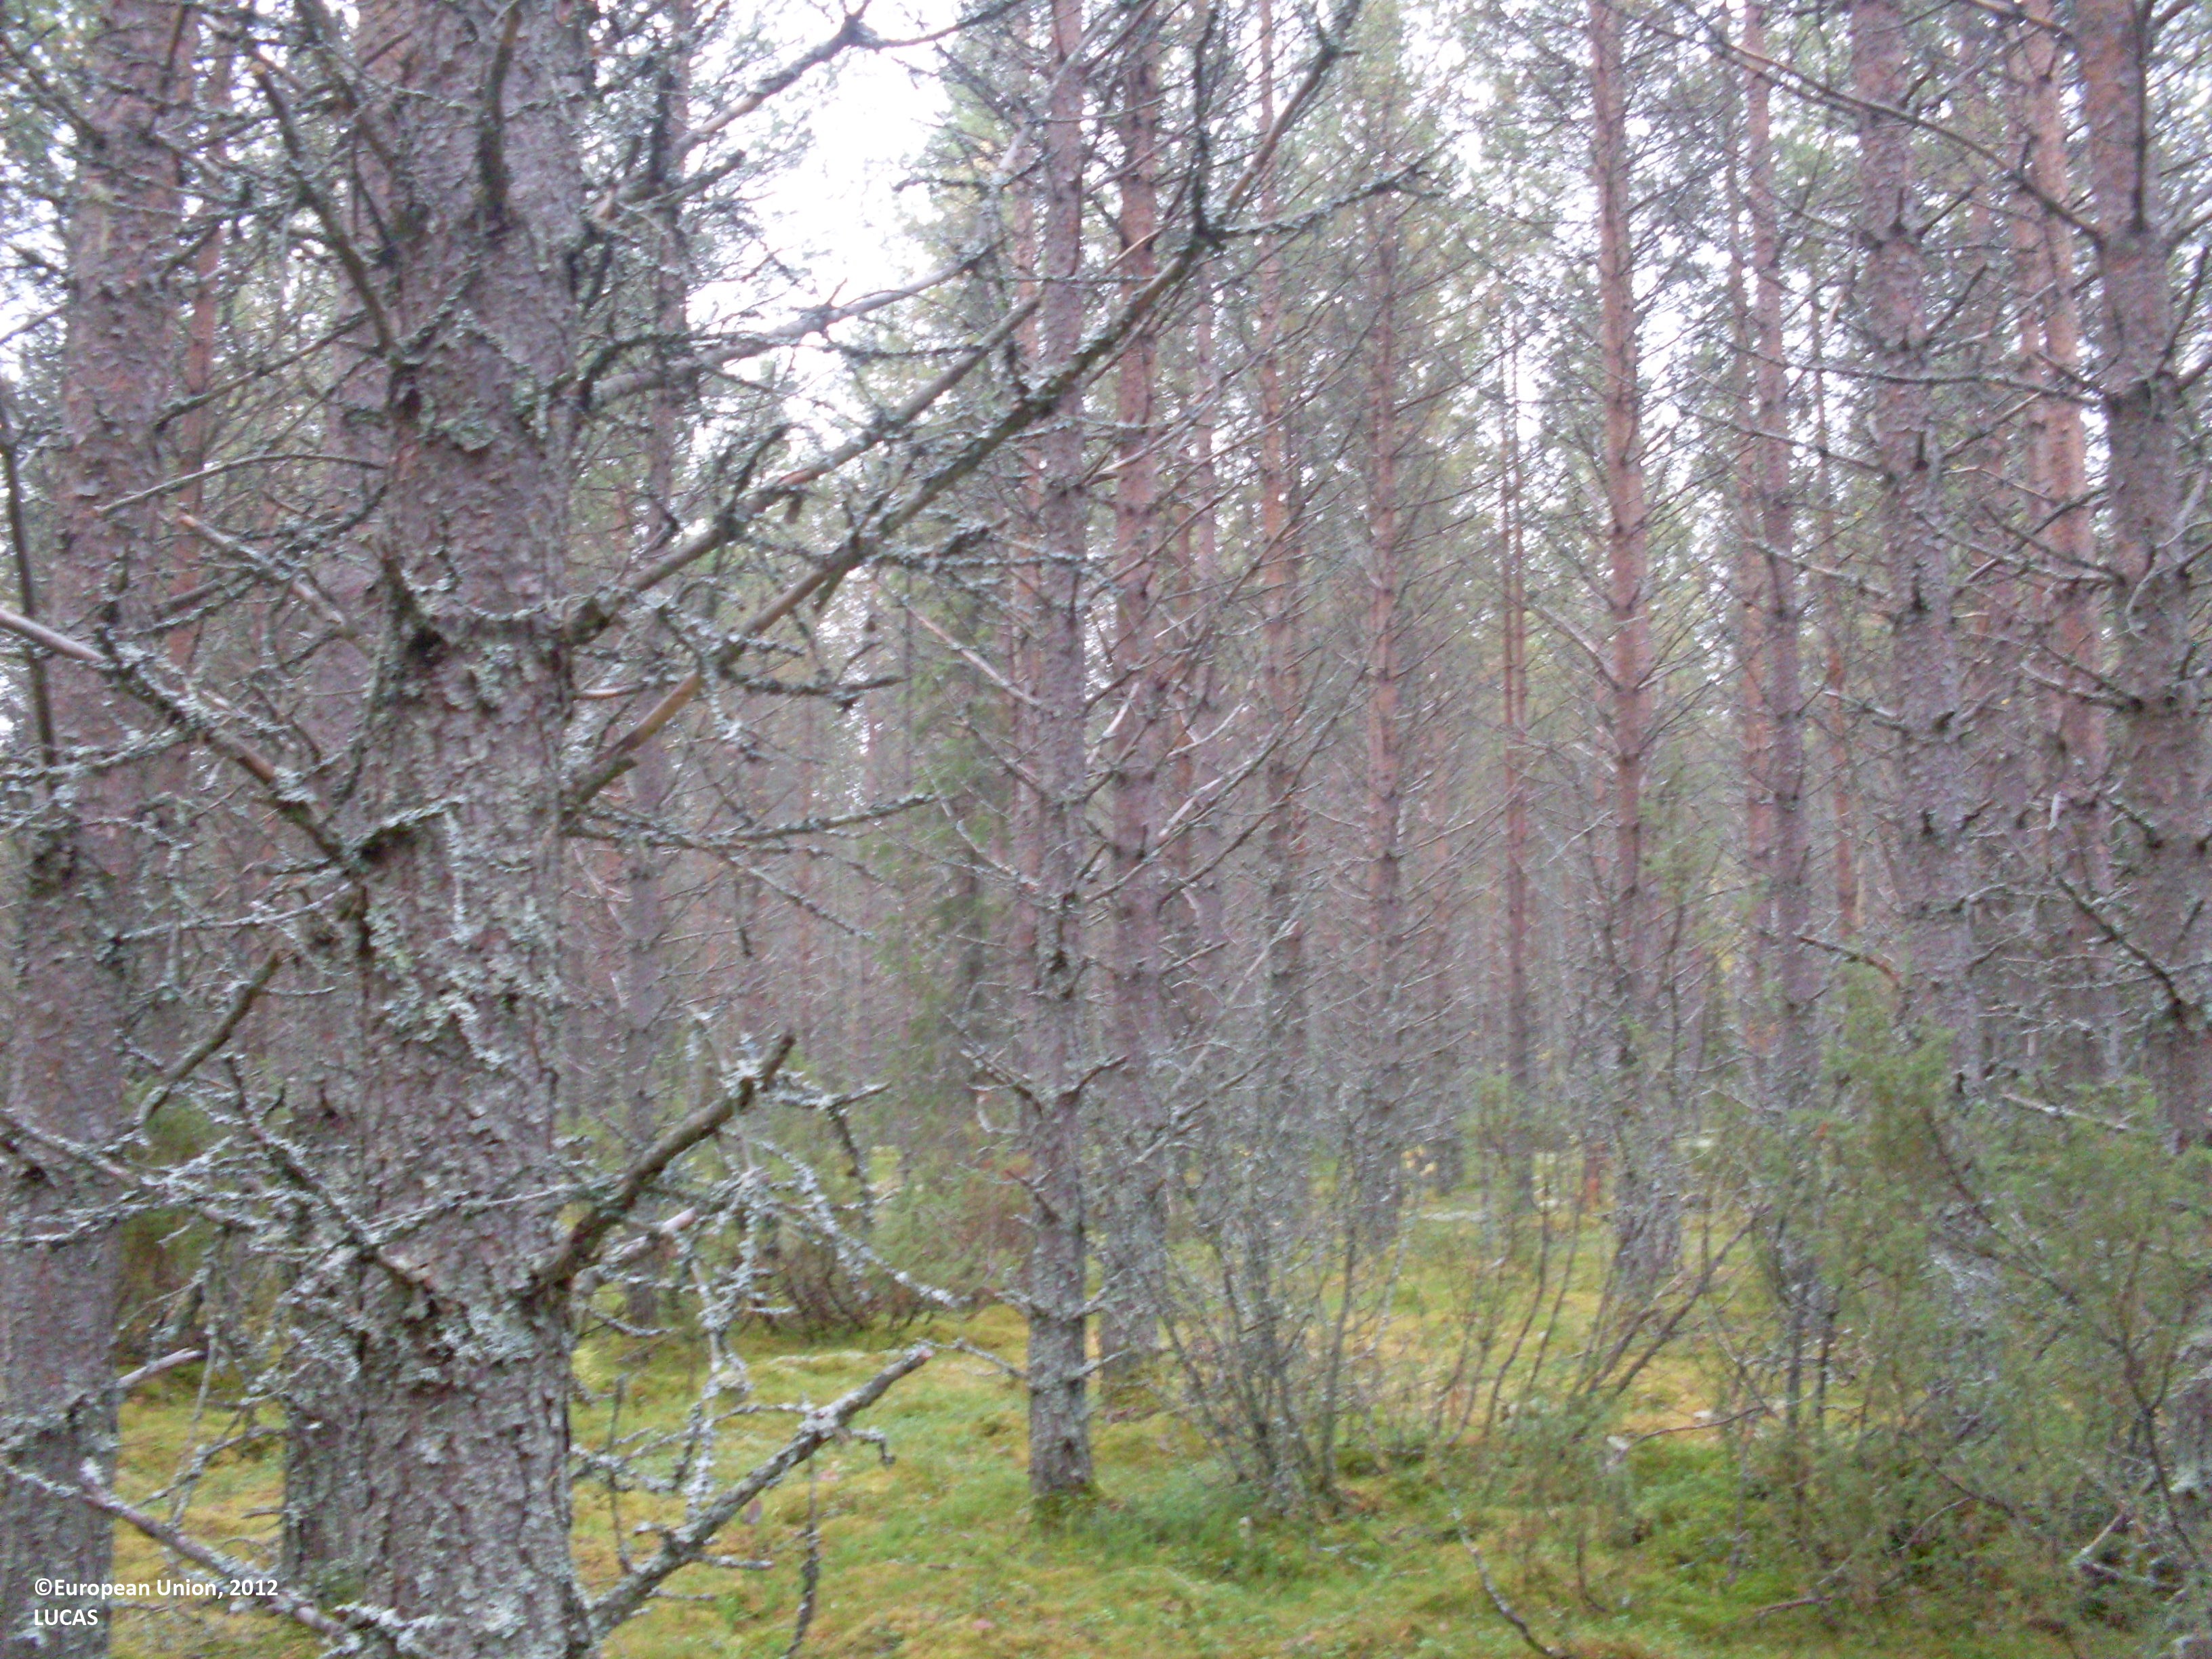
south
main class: Woodland
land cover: Pine dominated mixed woodland
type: boreal forest
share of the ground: 50 - 75 %
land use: Forestry
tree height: > 5 m
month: September
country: FI
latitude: 64.5670
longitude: 28.4769
